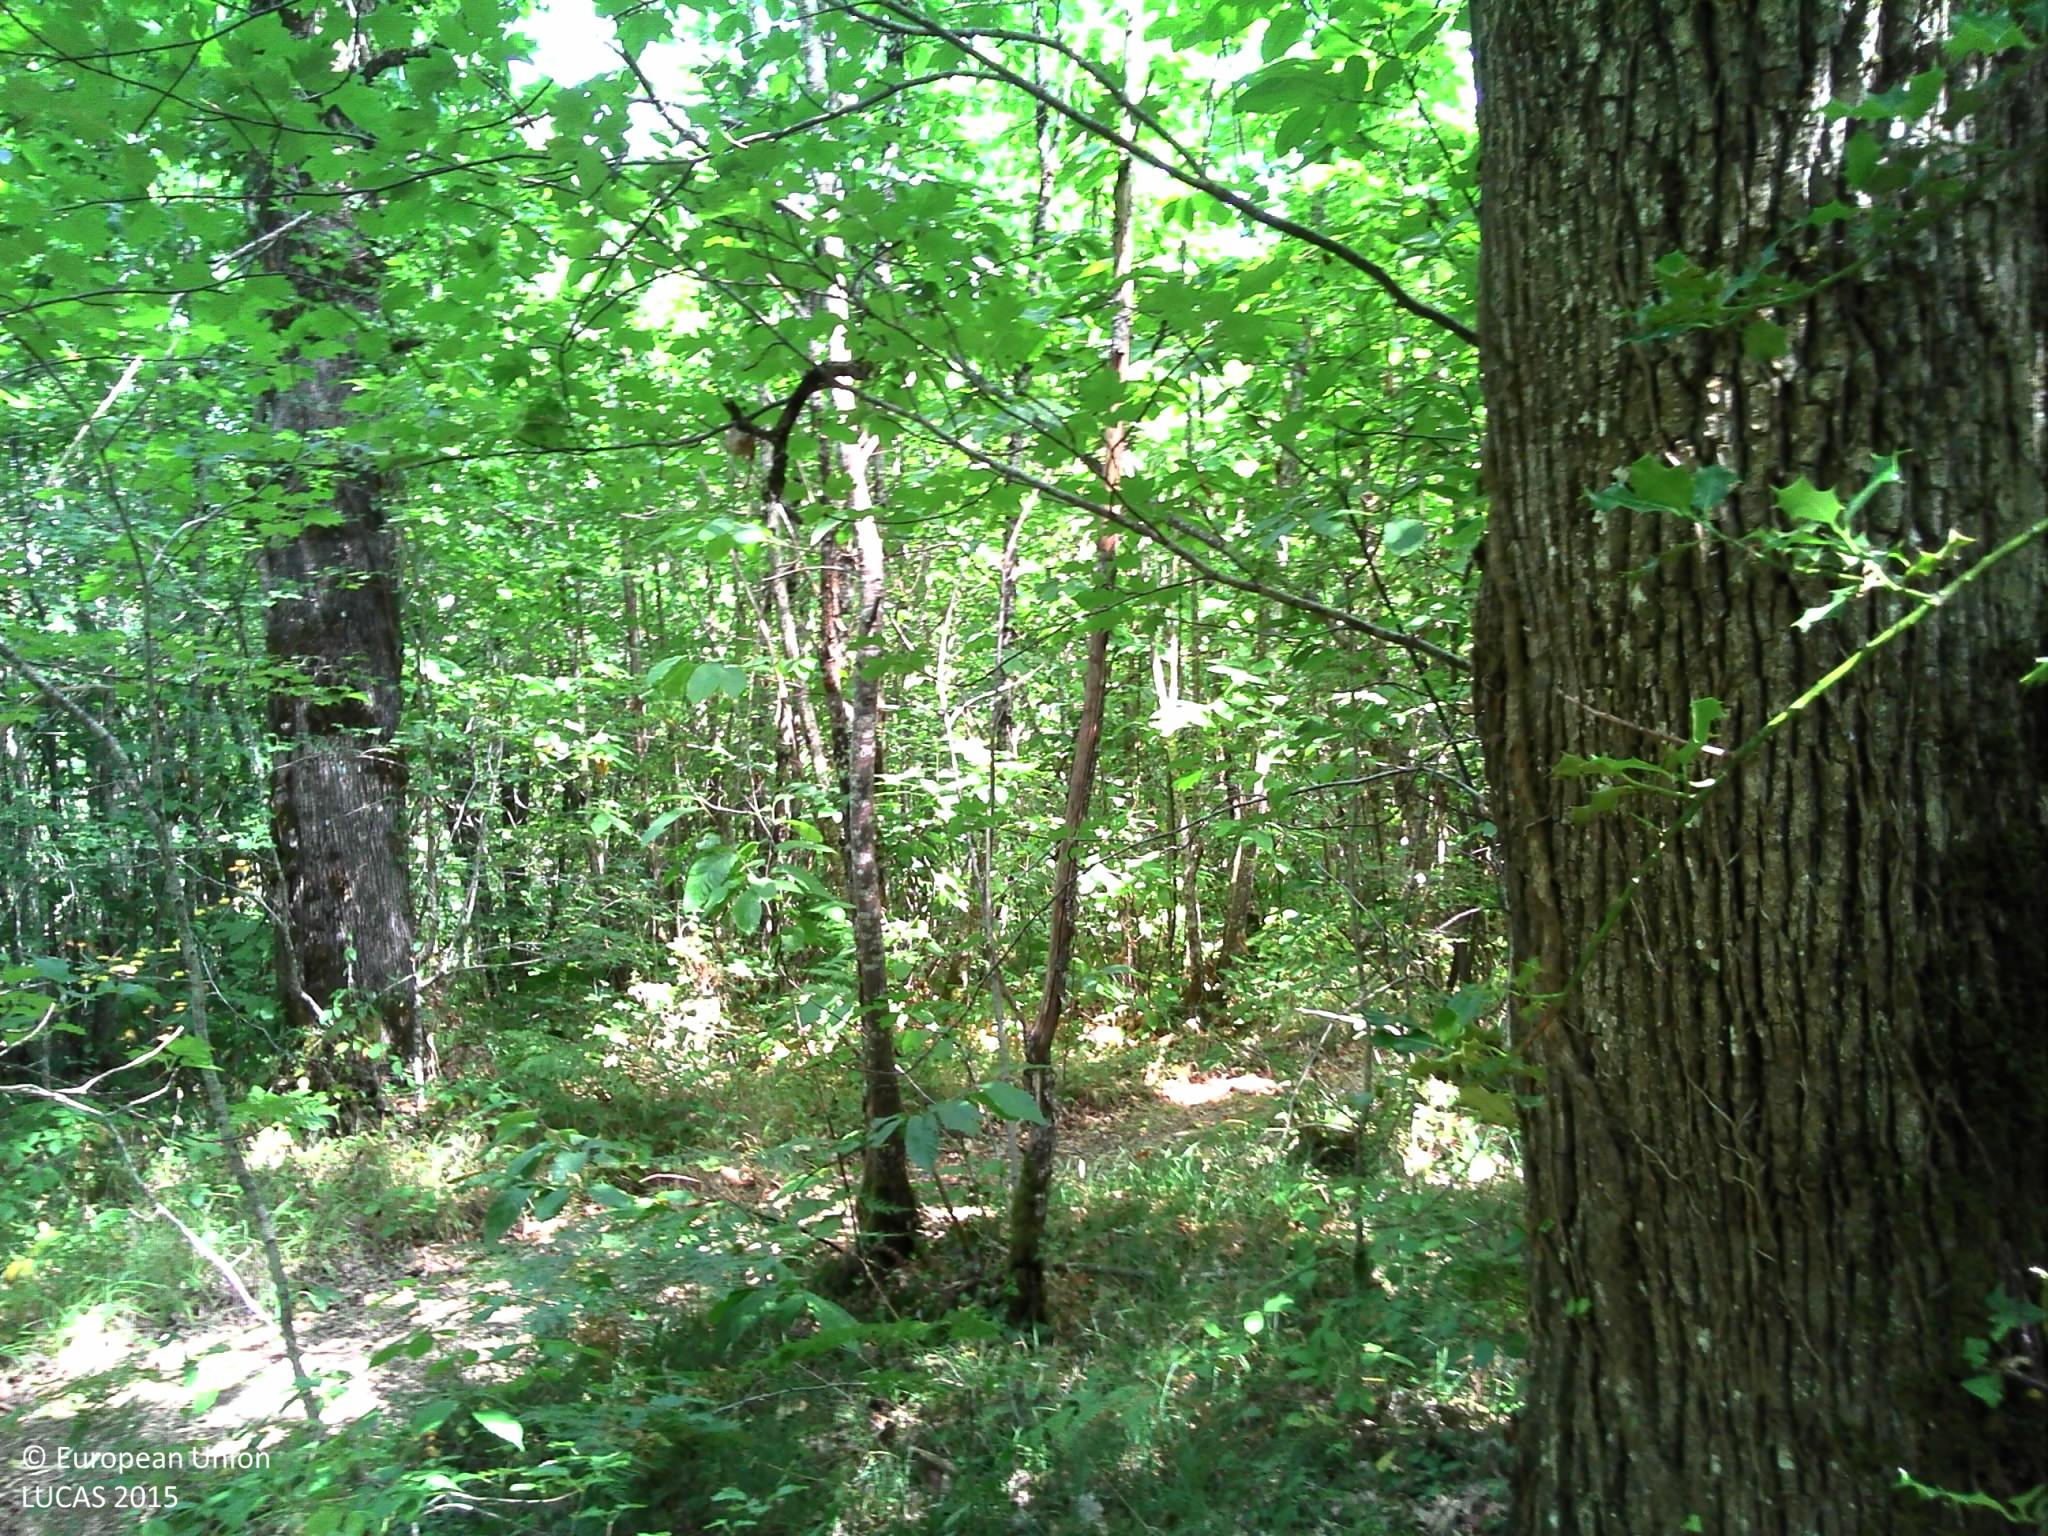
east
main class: Woodland
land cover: Broadleaved woodland
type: thermophilous deciduous forest
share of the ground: > 75 %
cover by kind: broadleaved forest trees 75 %, herbaceous plants 15 %, shrubs 10 %
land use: Forestry
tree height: > 5 m
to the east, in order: Broadleaved woodland; Tracks; Broadleaved woodland; Sunflower; Broadleaved woodland
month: July
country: FR
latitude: 45.1737
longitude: 0.7910
